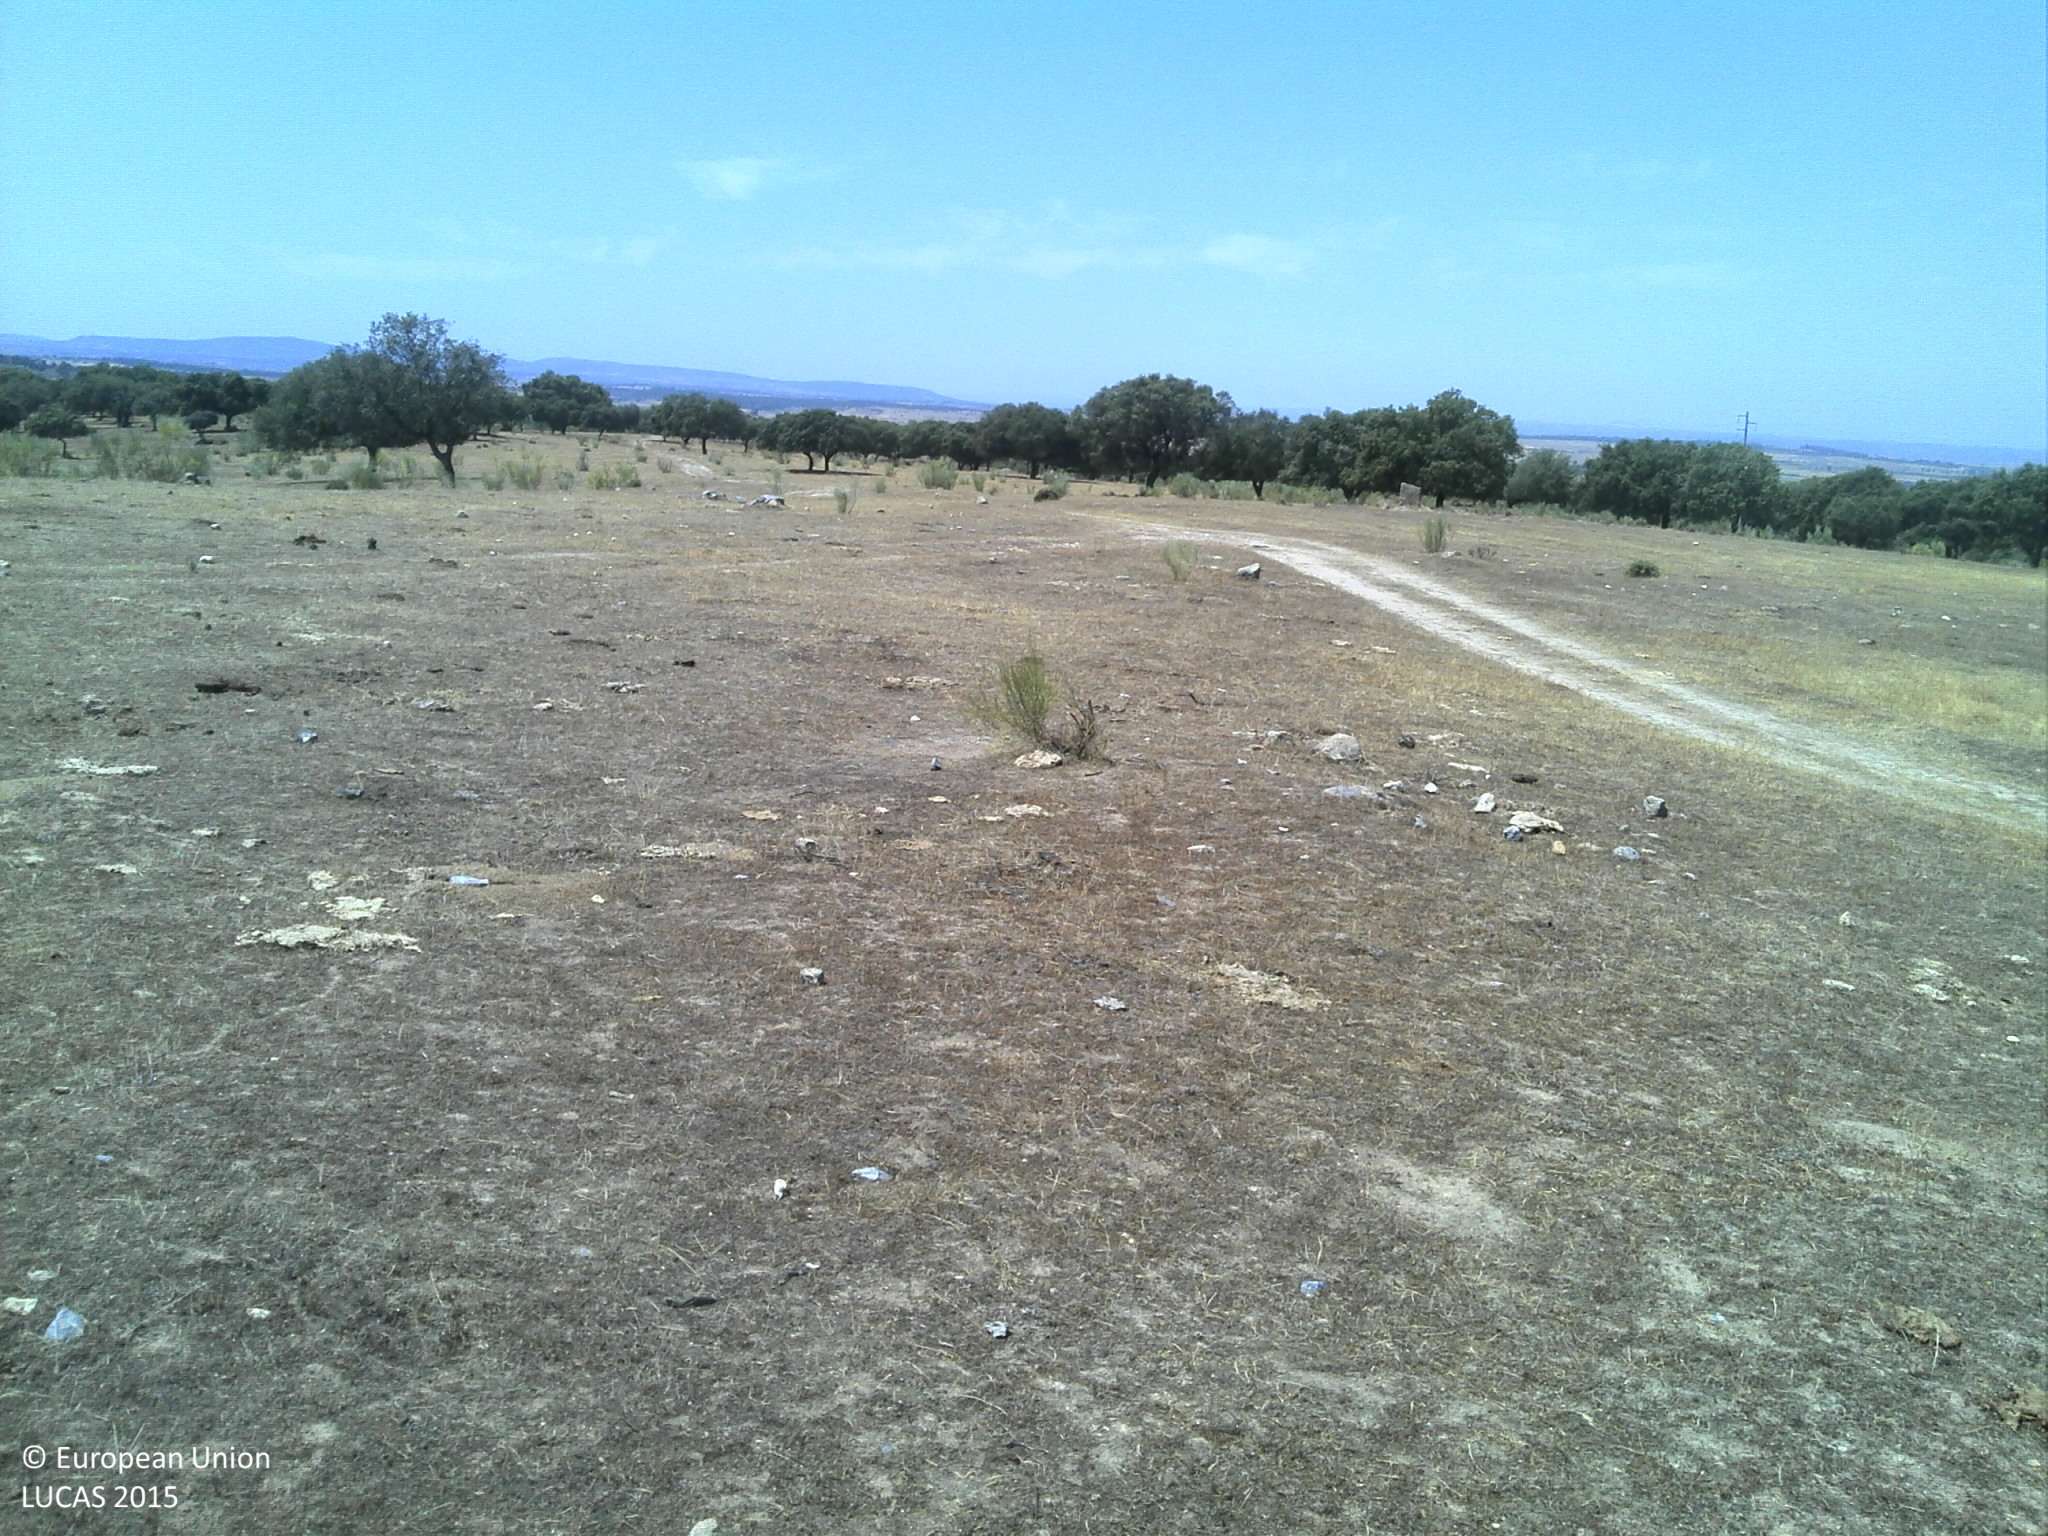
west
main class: Grassland
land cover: Grassland without tree/shrub cover
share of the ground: 10 - 25 %
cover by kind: unconsolidated bare surface 70 %, herbaceous plants 25 %
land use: Agriculture (excluding fallow land and kitchen gardens)
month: June
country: PT
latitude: 39.8387
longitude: -7.1166
